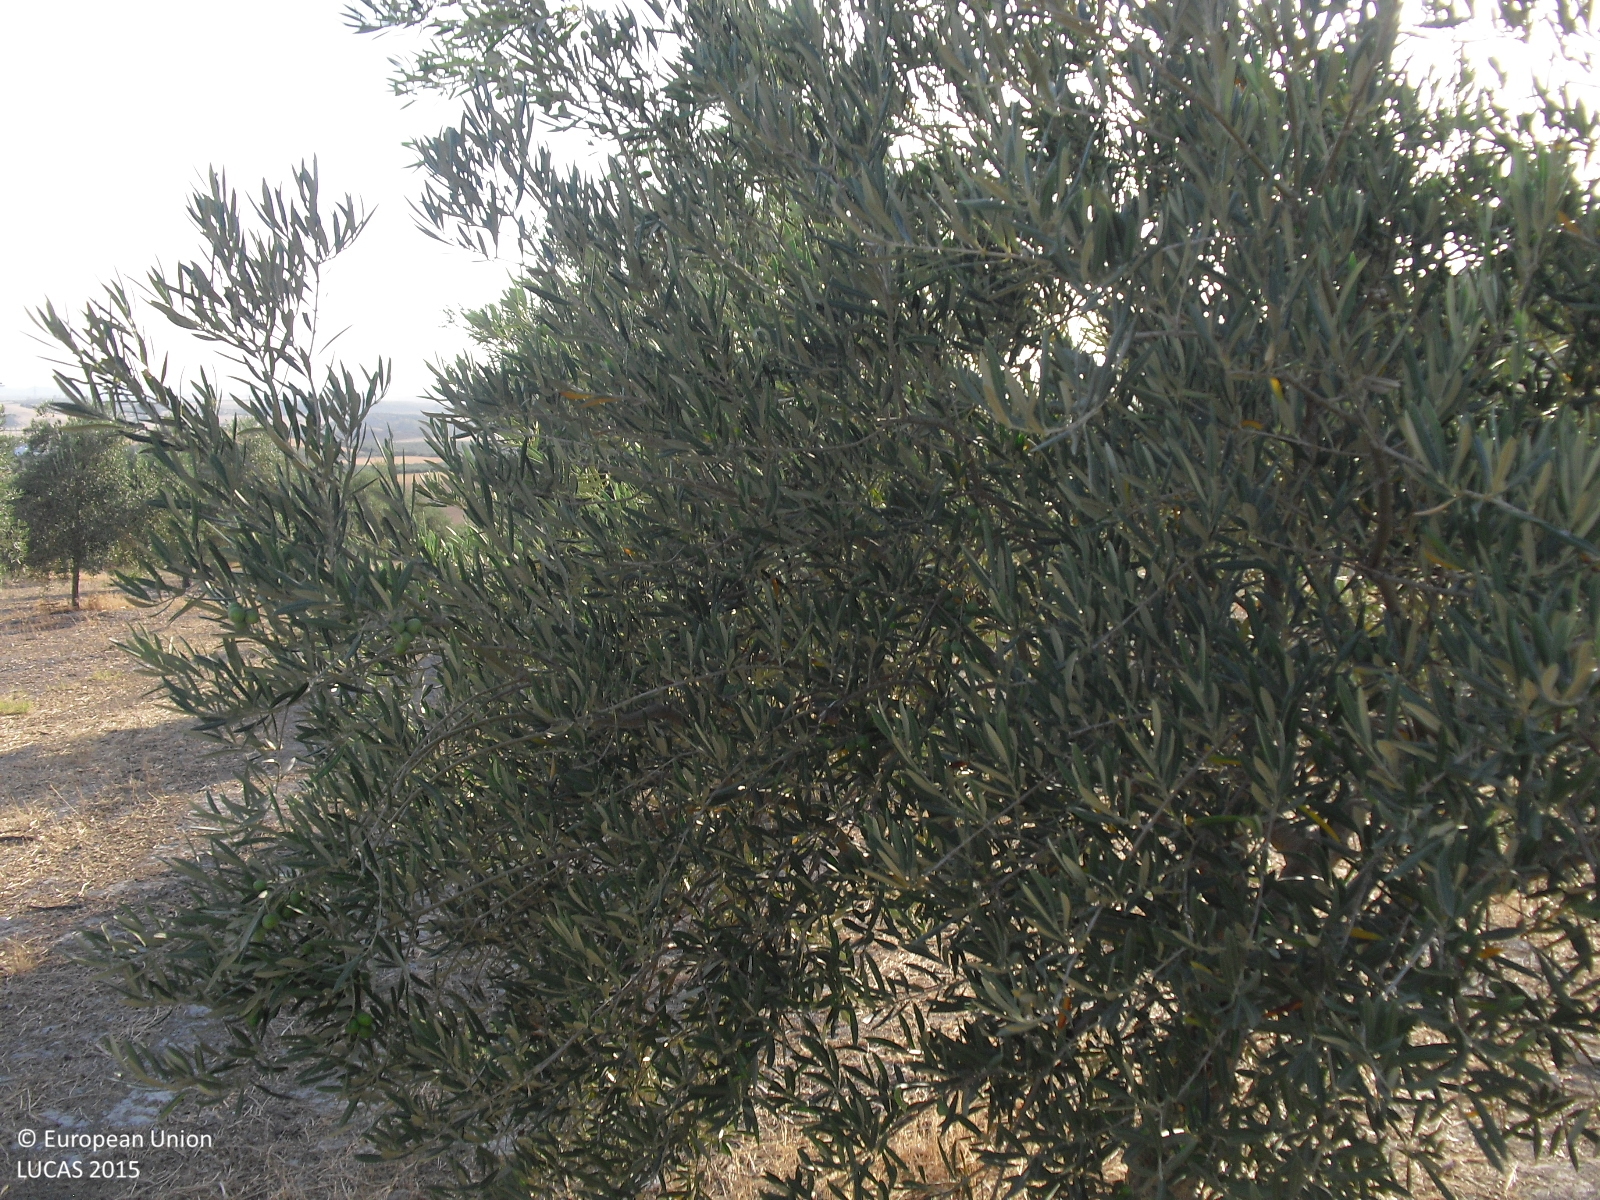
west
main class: Cropland
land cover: Olive groves
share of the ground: 25 - 50 %
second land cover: Other bare soil
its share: > 75 %
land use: Agriculture (excluding fallow land and kitchen gardens)
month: July
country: ES
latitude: 37.0764
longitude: -5.4990
